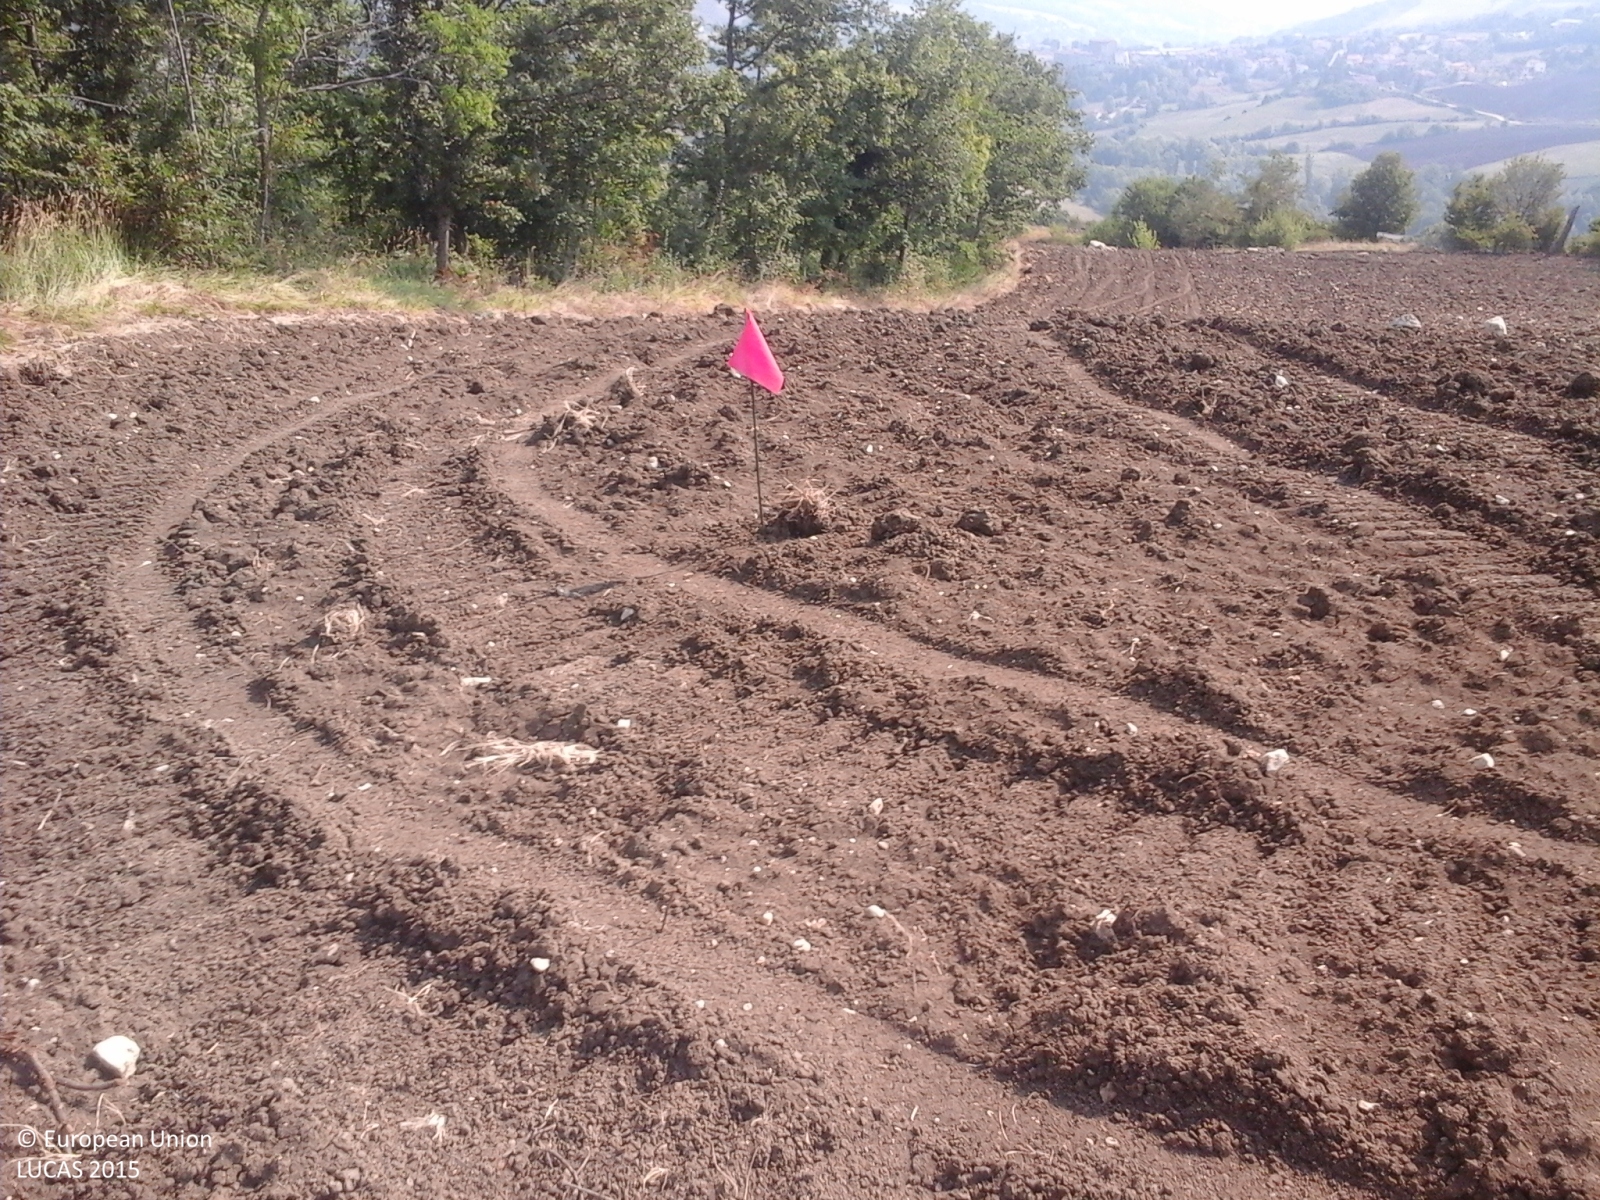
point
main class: Cropland
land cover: Oats
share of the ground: > 75 %
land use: Agriculture (excluding fallow land and kitchen gardens)
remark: Harvested field
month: August
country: IT
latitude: 43.8357
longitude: 12.3944
